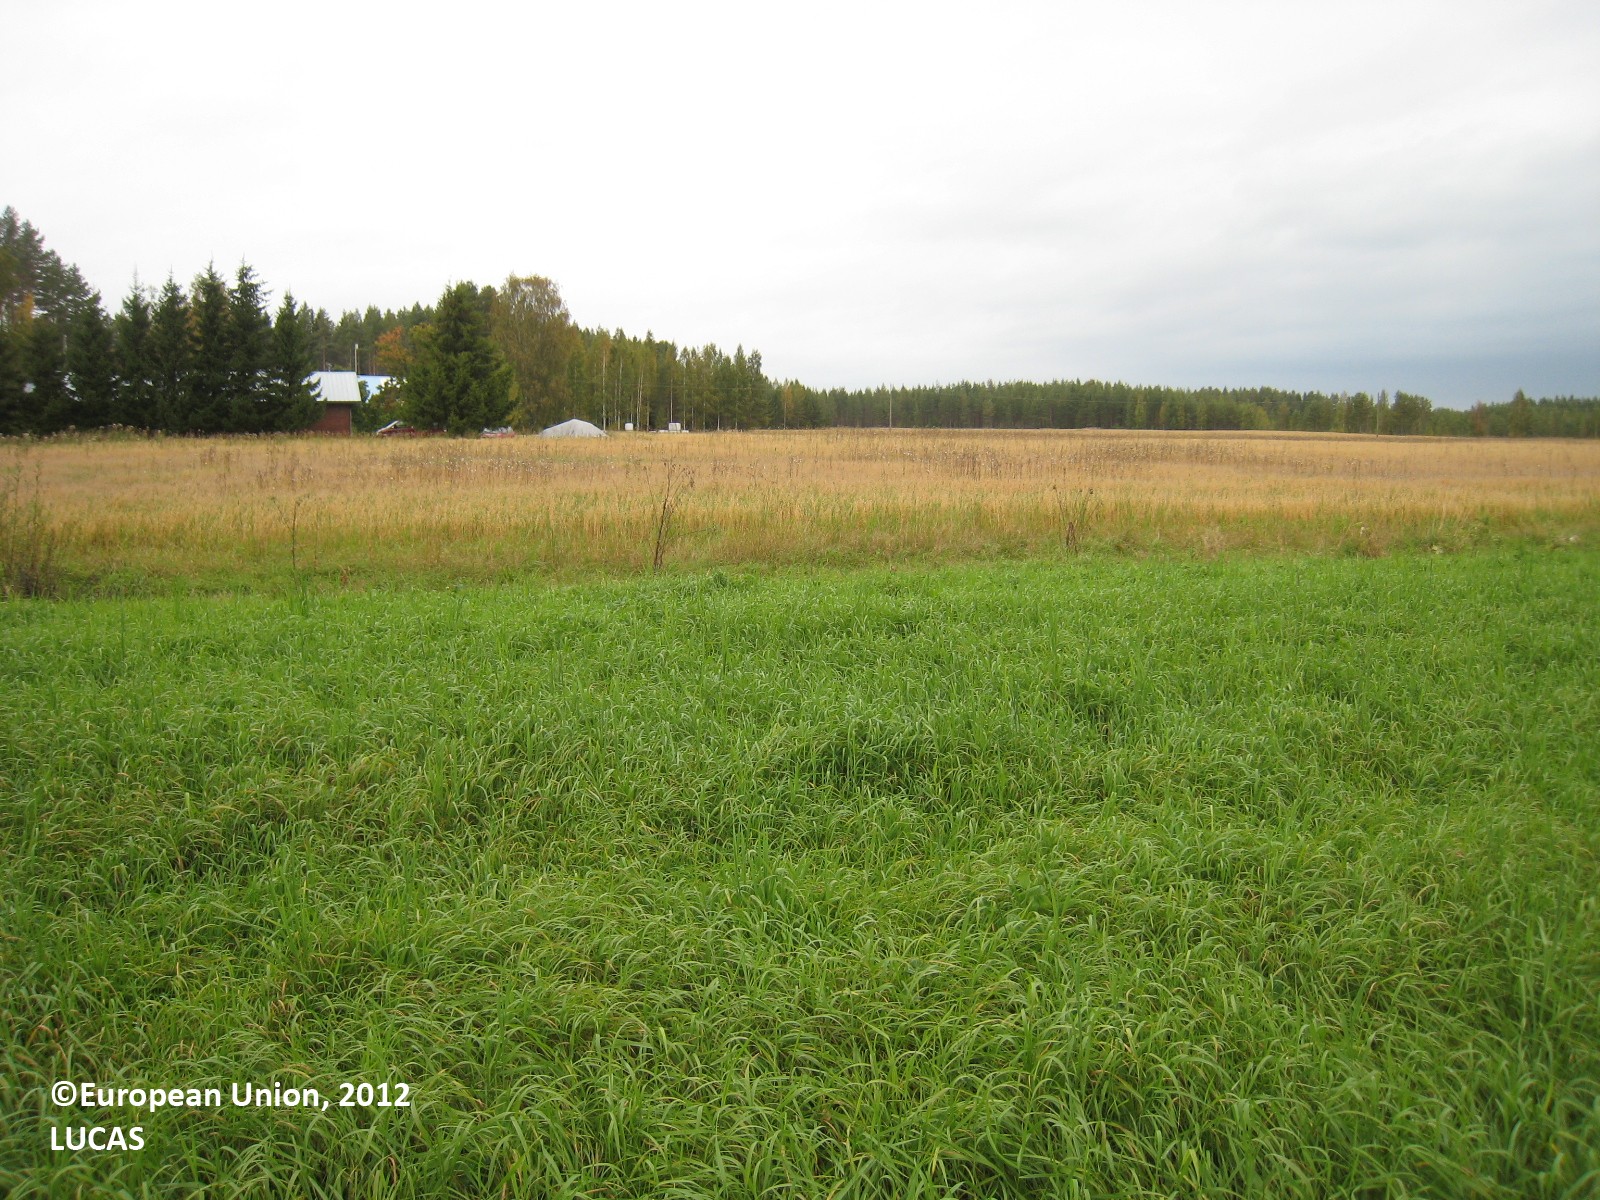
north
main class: Cropland
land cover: Temporary grasslands
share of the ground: > 75 %
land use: Agriculture (excluding fallow land and kitchen gardens)
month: September
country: FI
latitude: 62.7323
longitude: 26.6319
